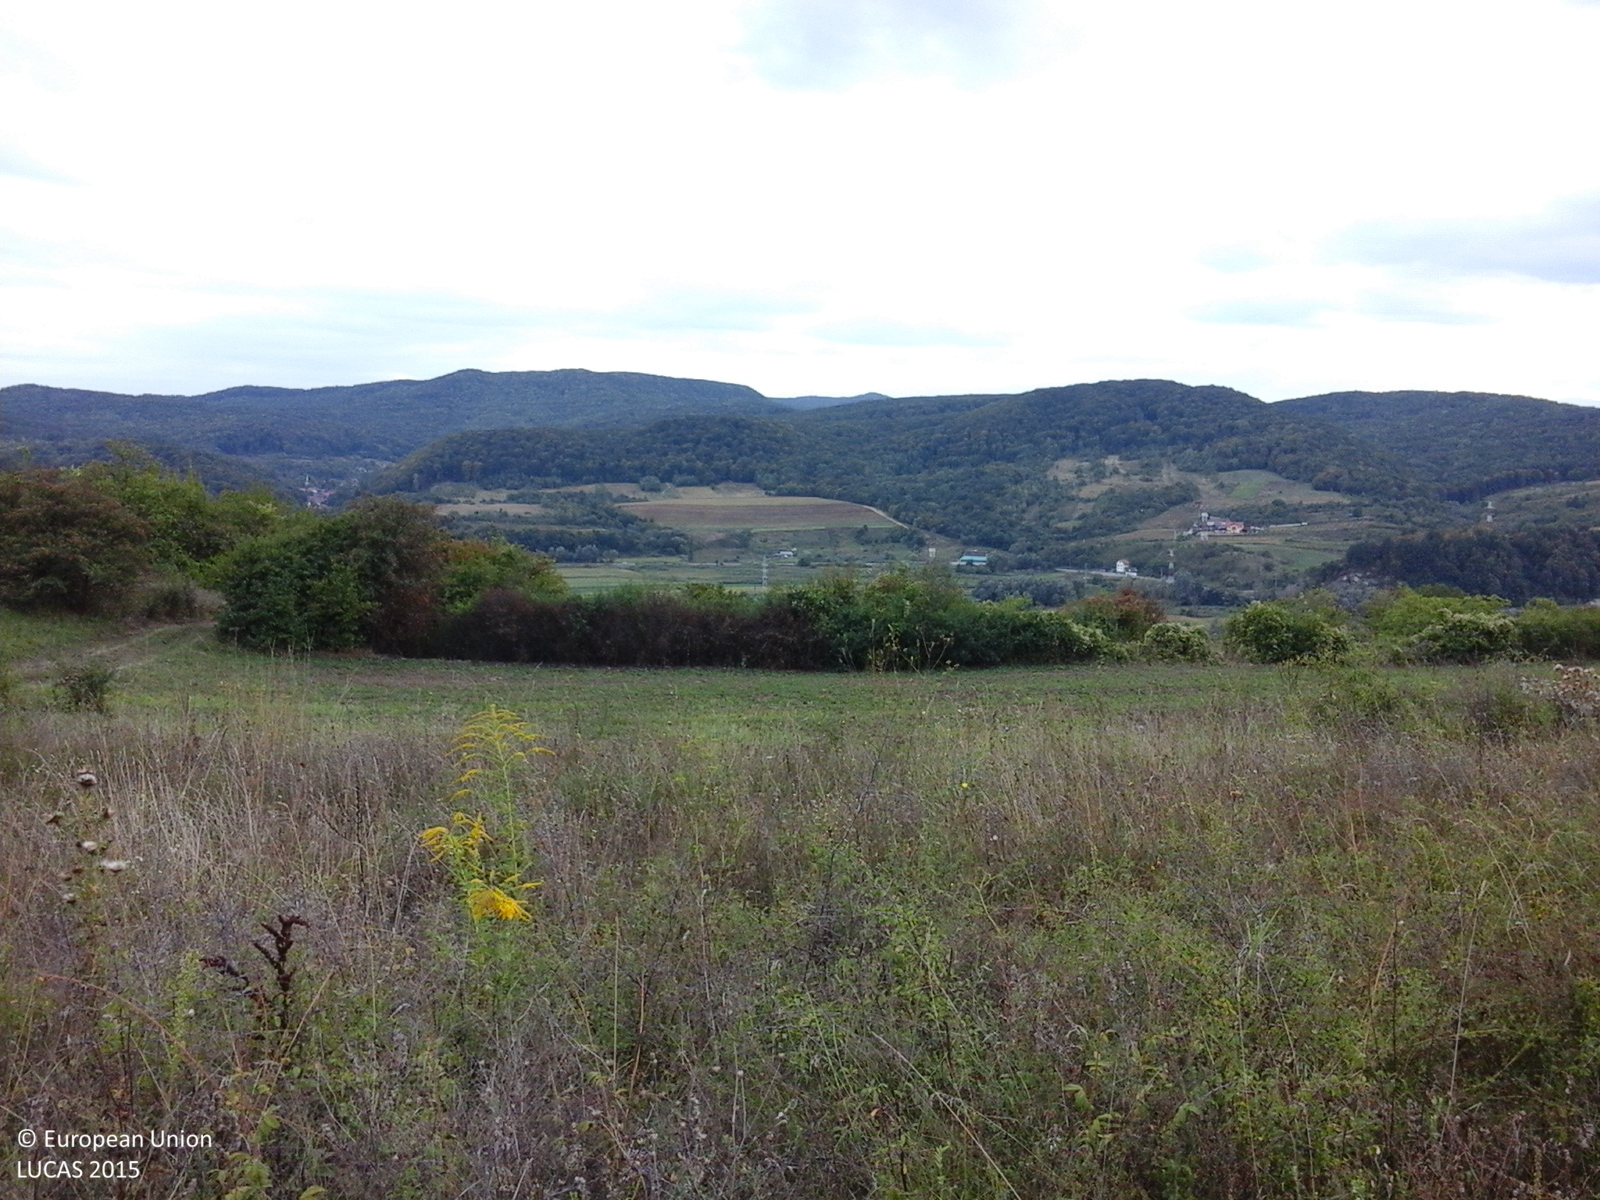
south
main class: Grassland
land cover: Spontaneously vegetated surfaces
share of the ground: > 75 %
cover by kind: herbaceous plants 100 %
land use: Agriculture (excluding fallow land and kitchen gardens)
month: September
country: RO
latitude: 47.2498
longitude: 23.2946
